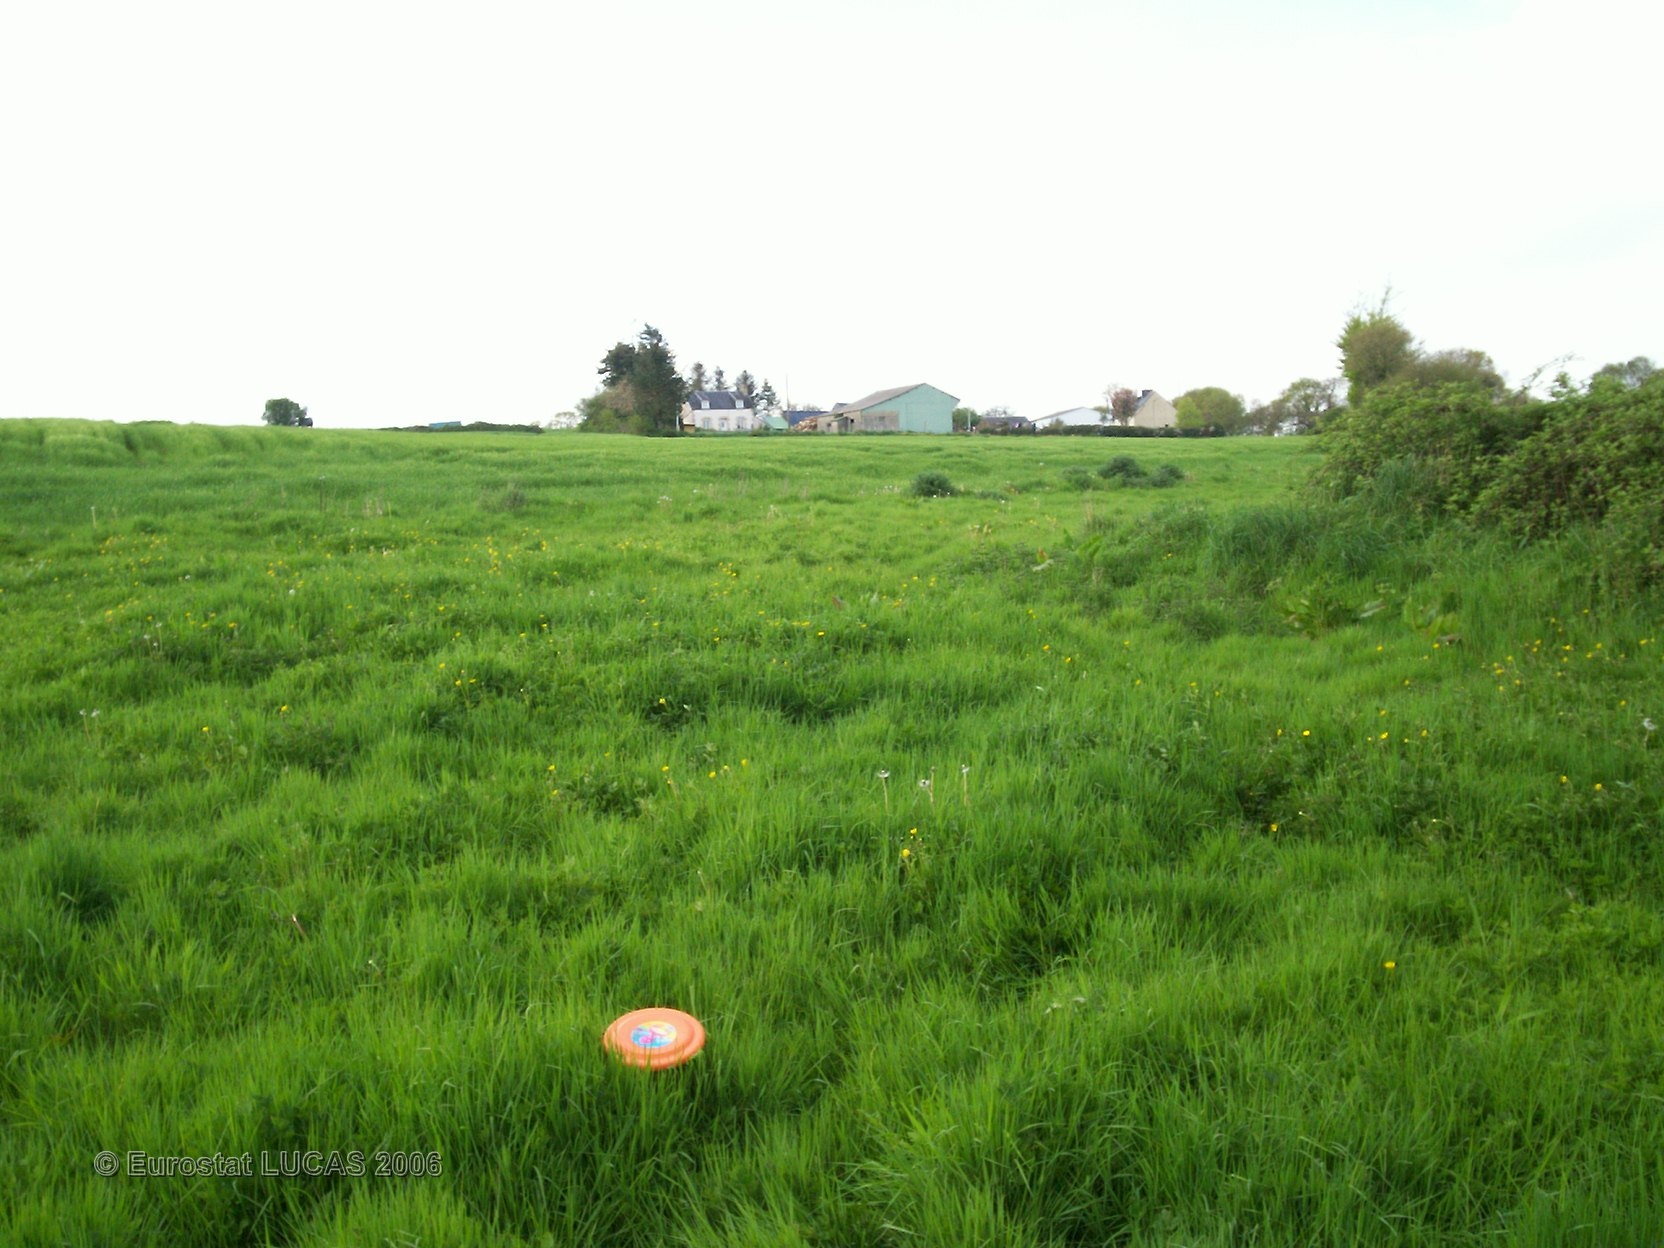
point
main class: Grassland
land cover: Grassland without tree/shrub cover
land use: Agriculture (excluding fallow land and kitchen gardens)
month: May
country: FR
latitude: 48.4295
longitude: -3.6368
